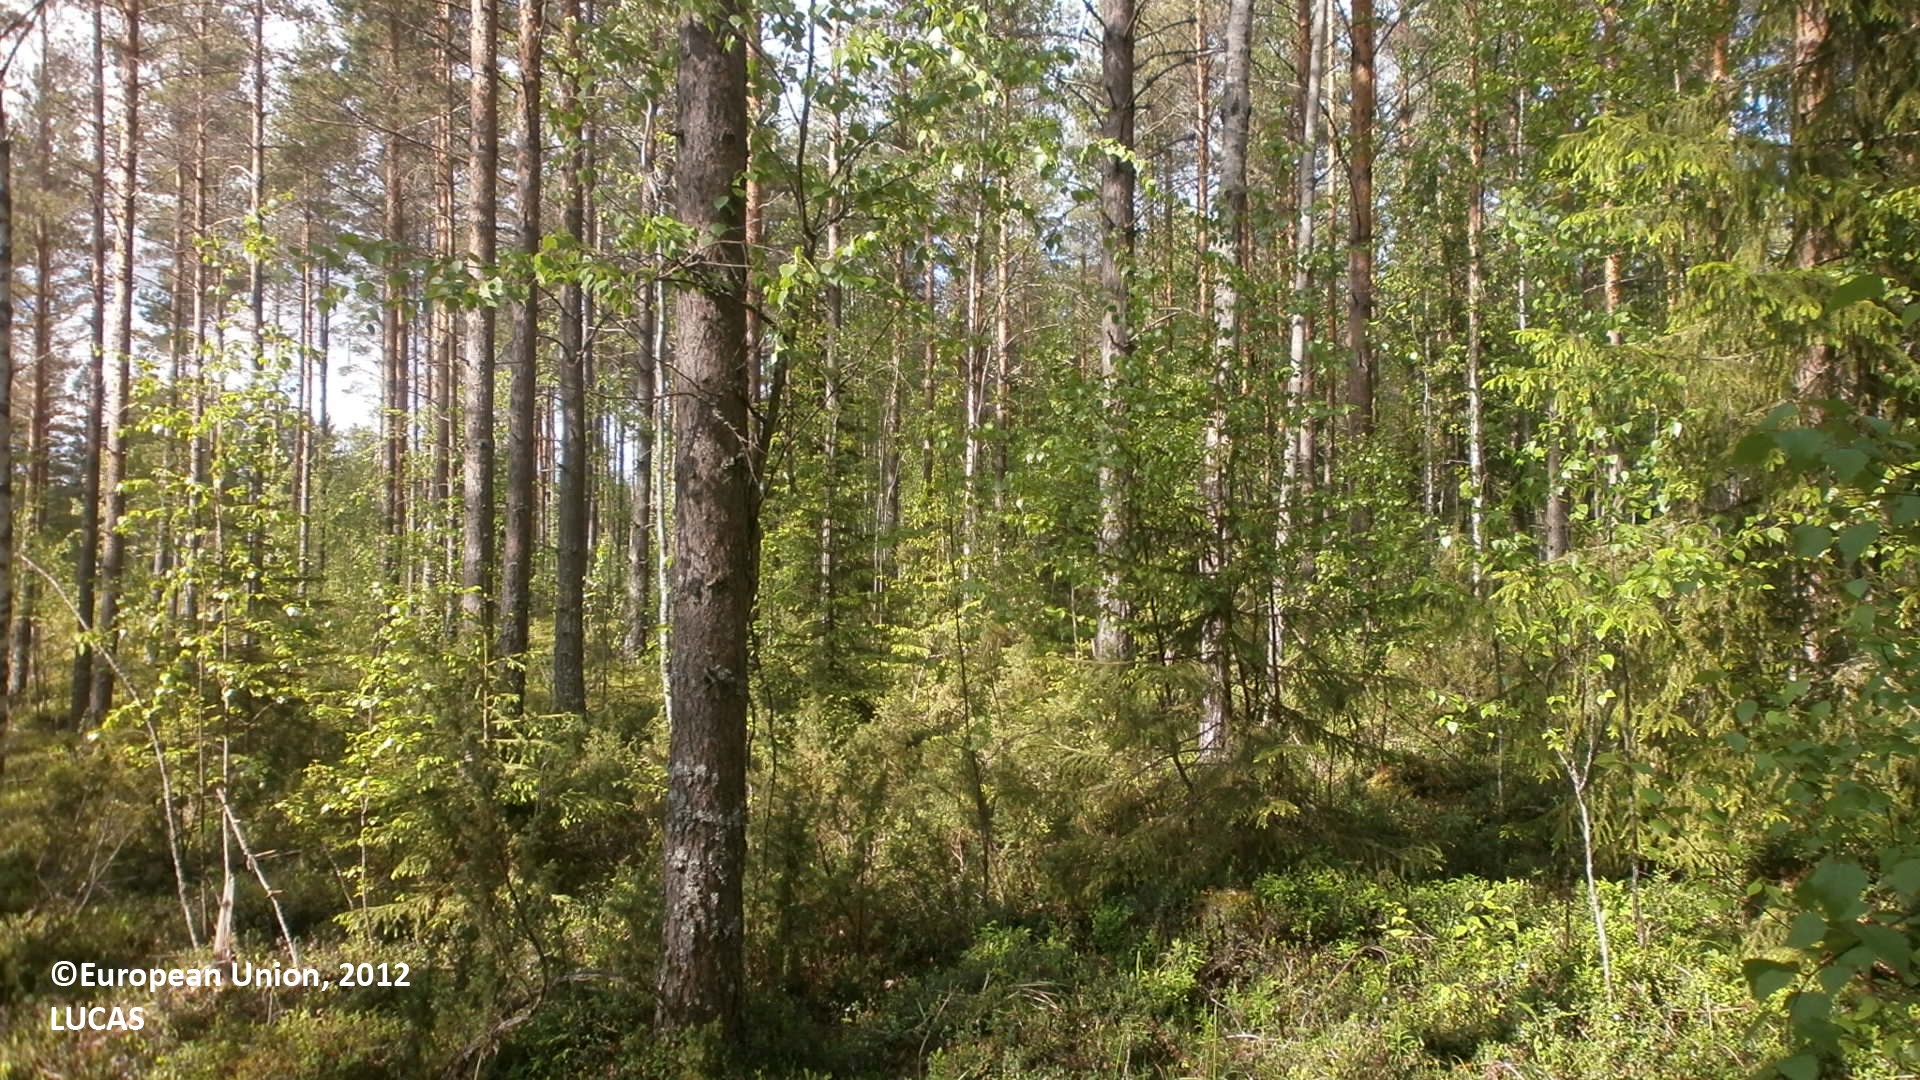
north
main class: Woodland
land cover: Pine dominated coniferous woodland
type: hemiboreal forest and nemoral coniferous forest and mixed broadleaved-coniferous forest
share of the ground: 50 - 75 %
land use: Forestry
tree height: > 5 m
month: June
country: FI
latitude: 64.0543
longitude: 25.6892
